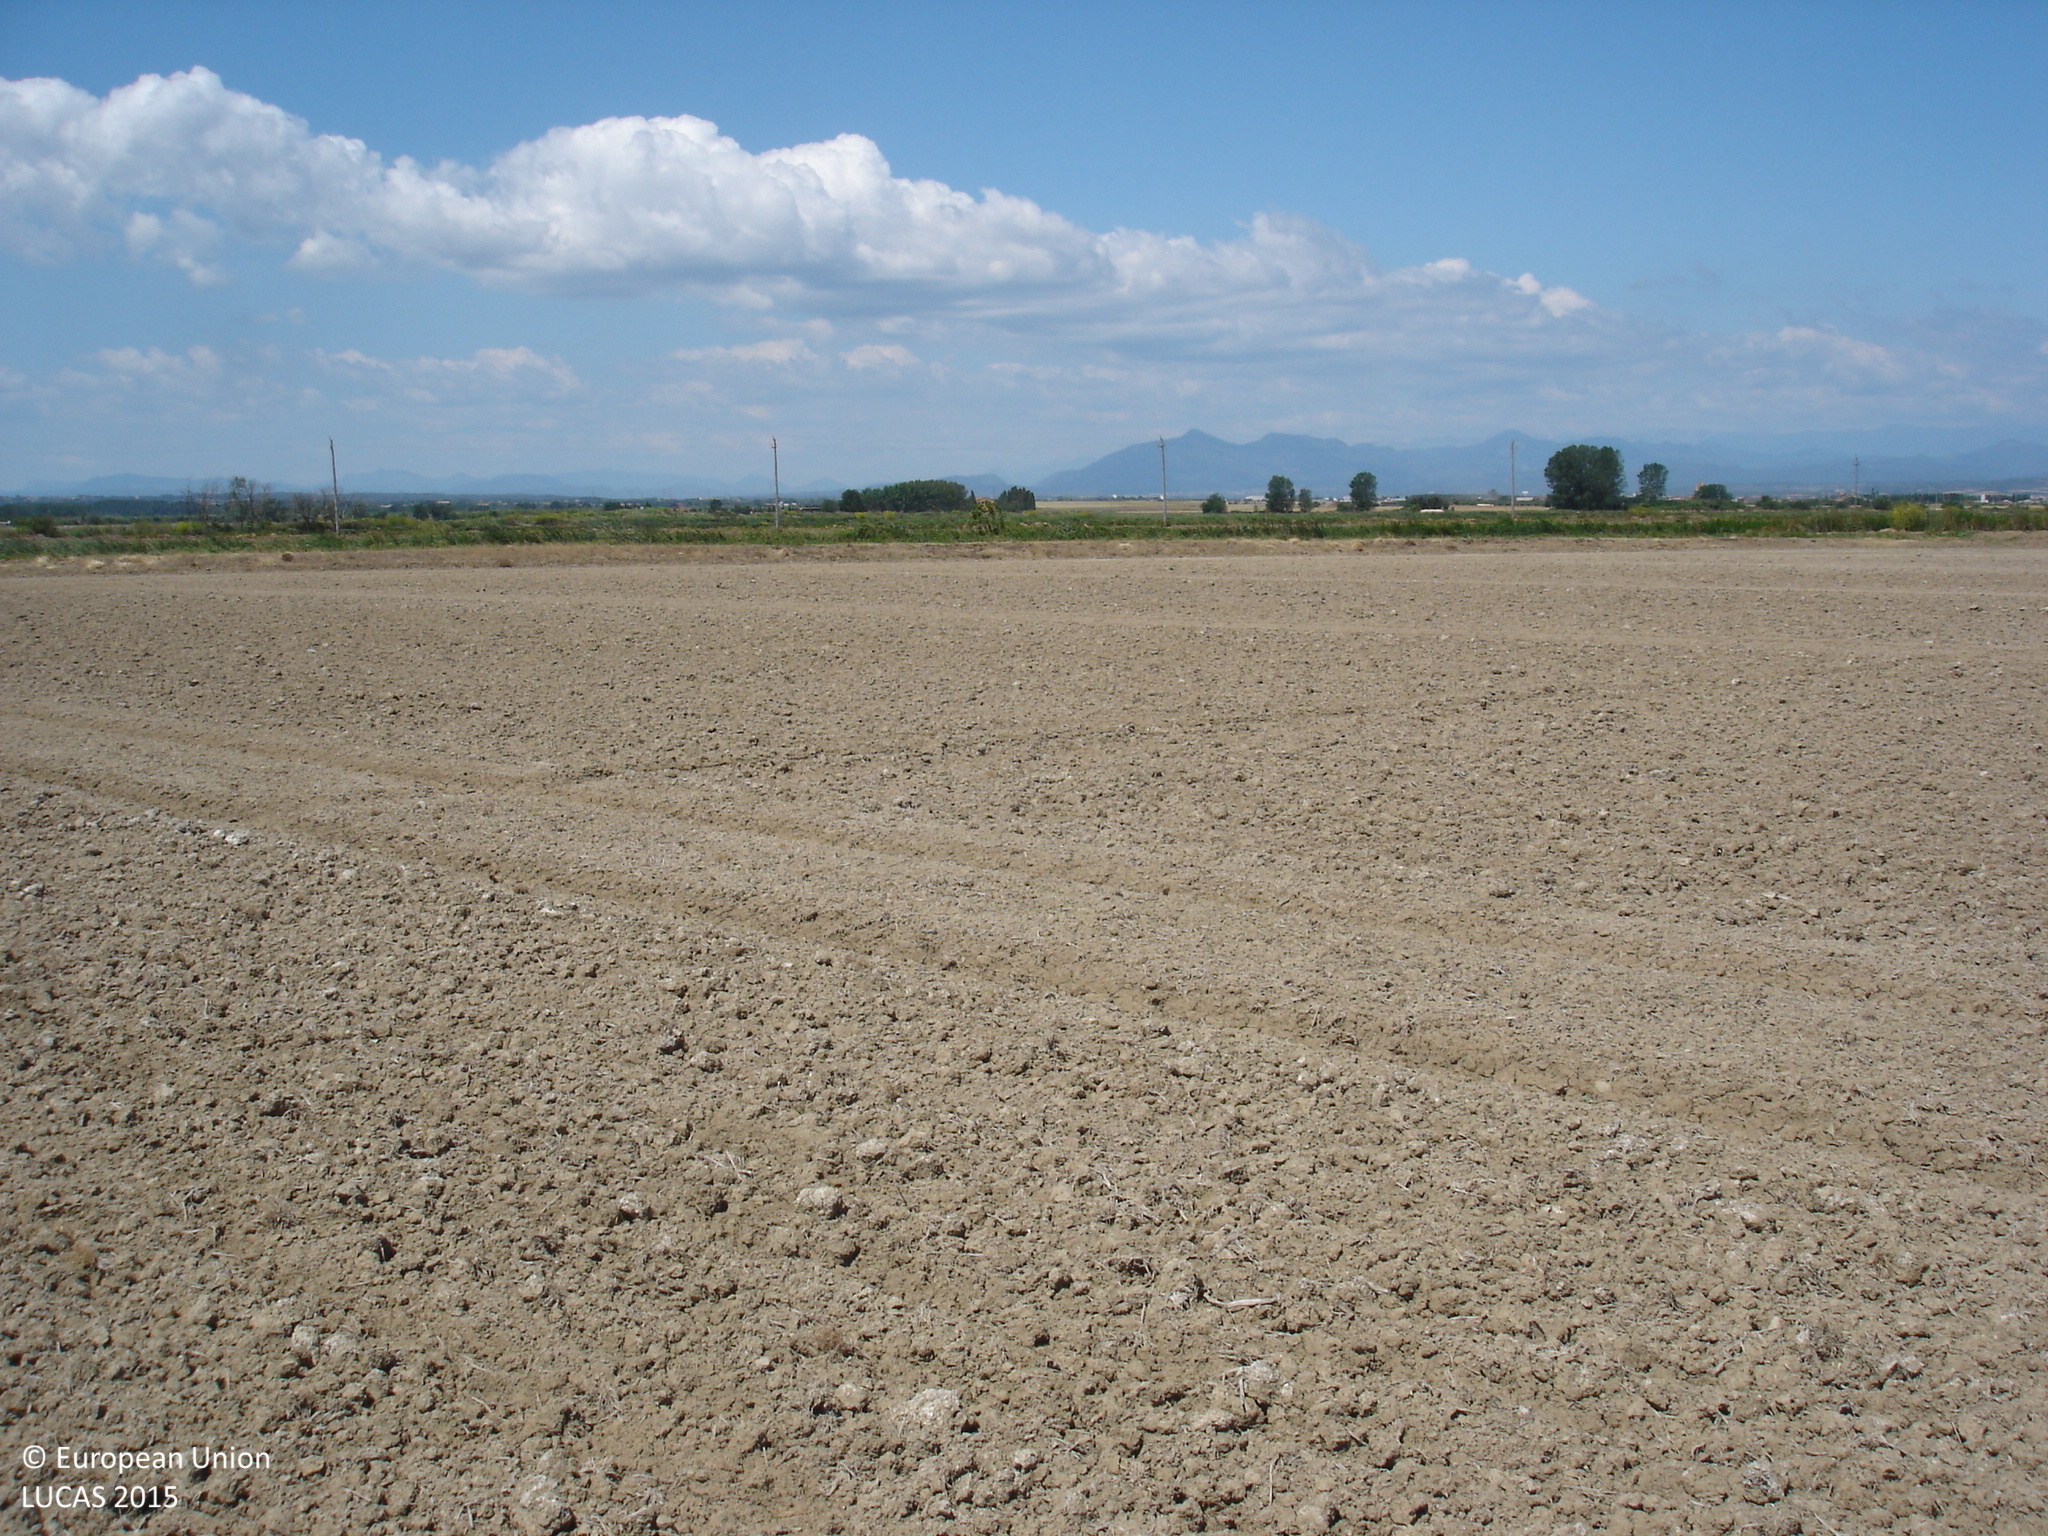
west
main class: Cropland
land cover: Rice
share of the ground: < 10 %
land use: Agriculture (excluding fallow land and kitchen gardens)
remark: Tilled/Sowed
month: May
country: ES
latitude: 42.2157
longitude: 3.0492
